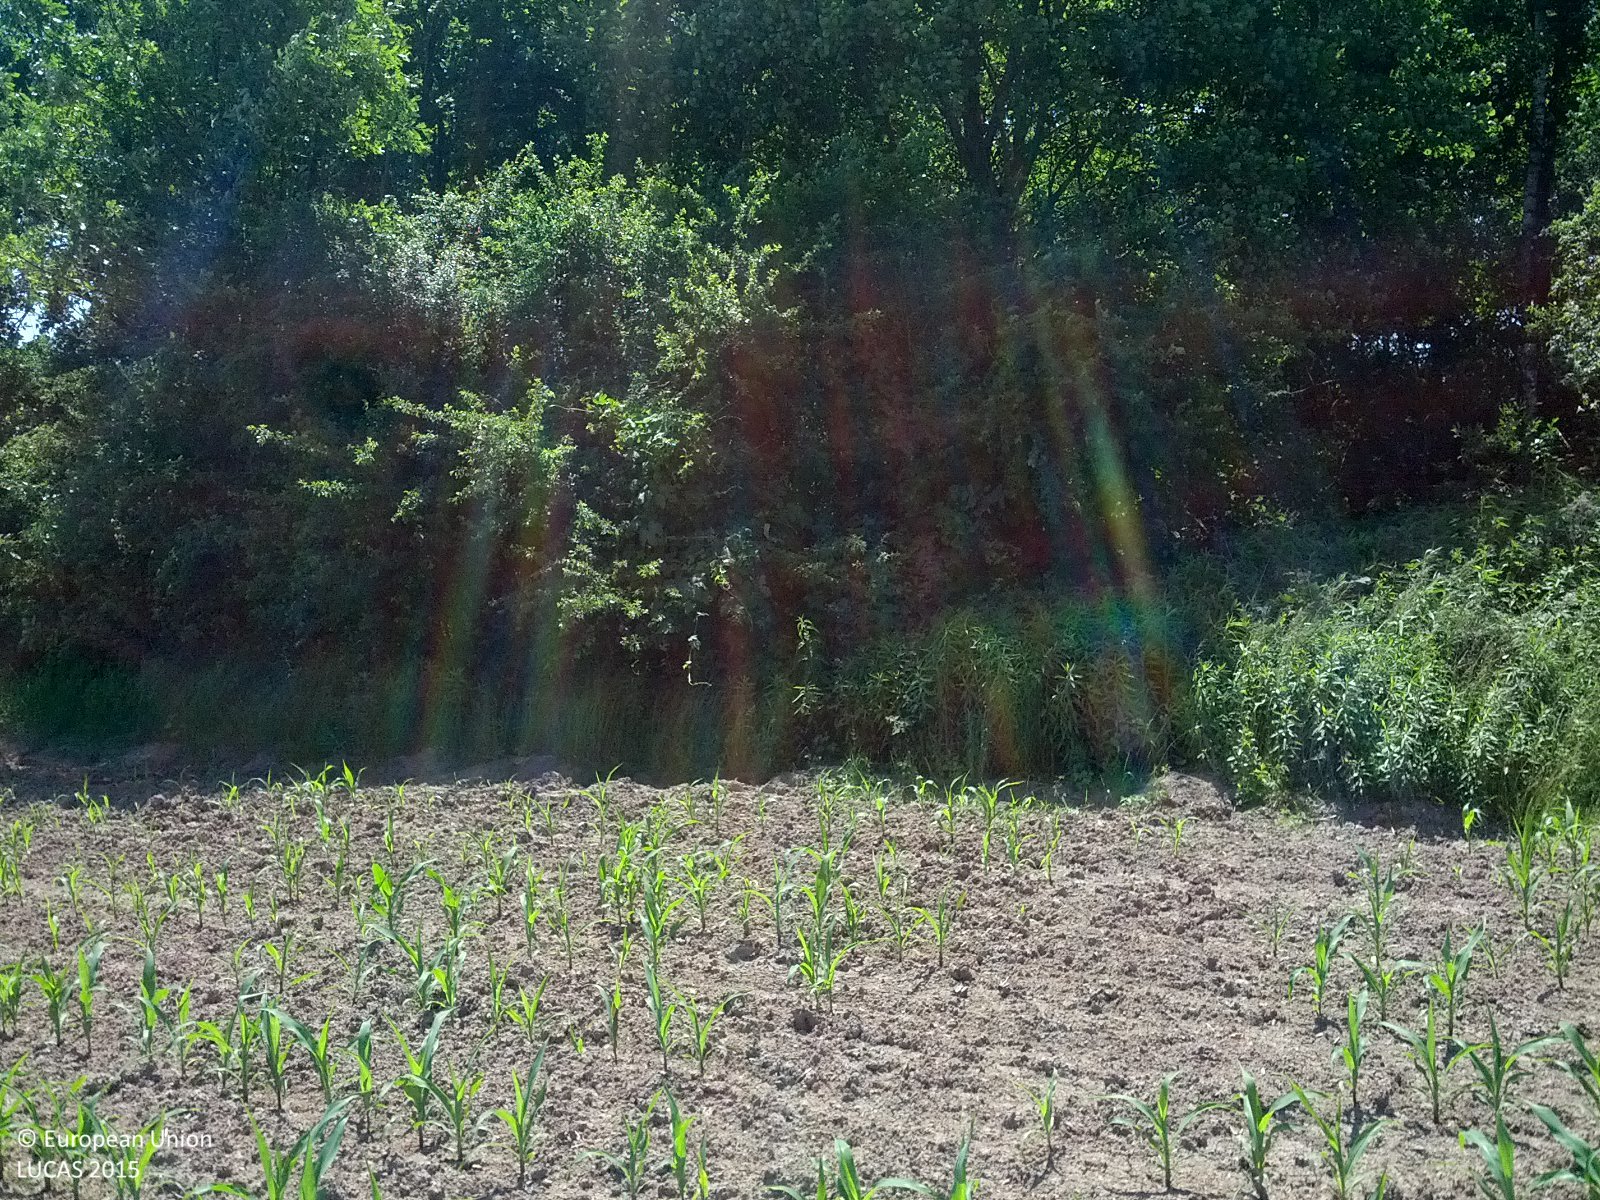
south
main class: Cropland
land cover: Maize
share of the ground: 10 - 25 %
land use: Agriculture (excluding fallow land and kitchen gardens)
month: June
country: AT
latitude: 47.0679
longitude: 16.3094
